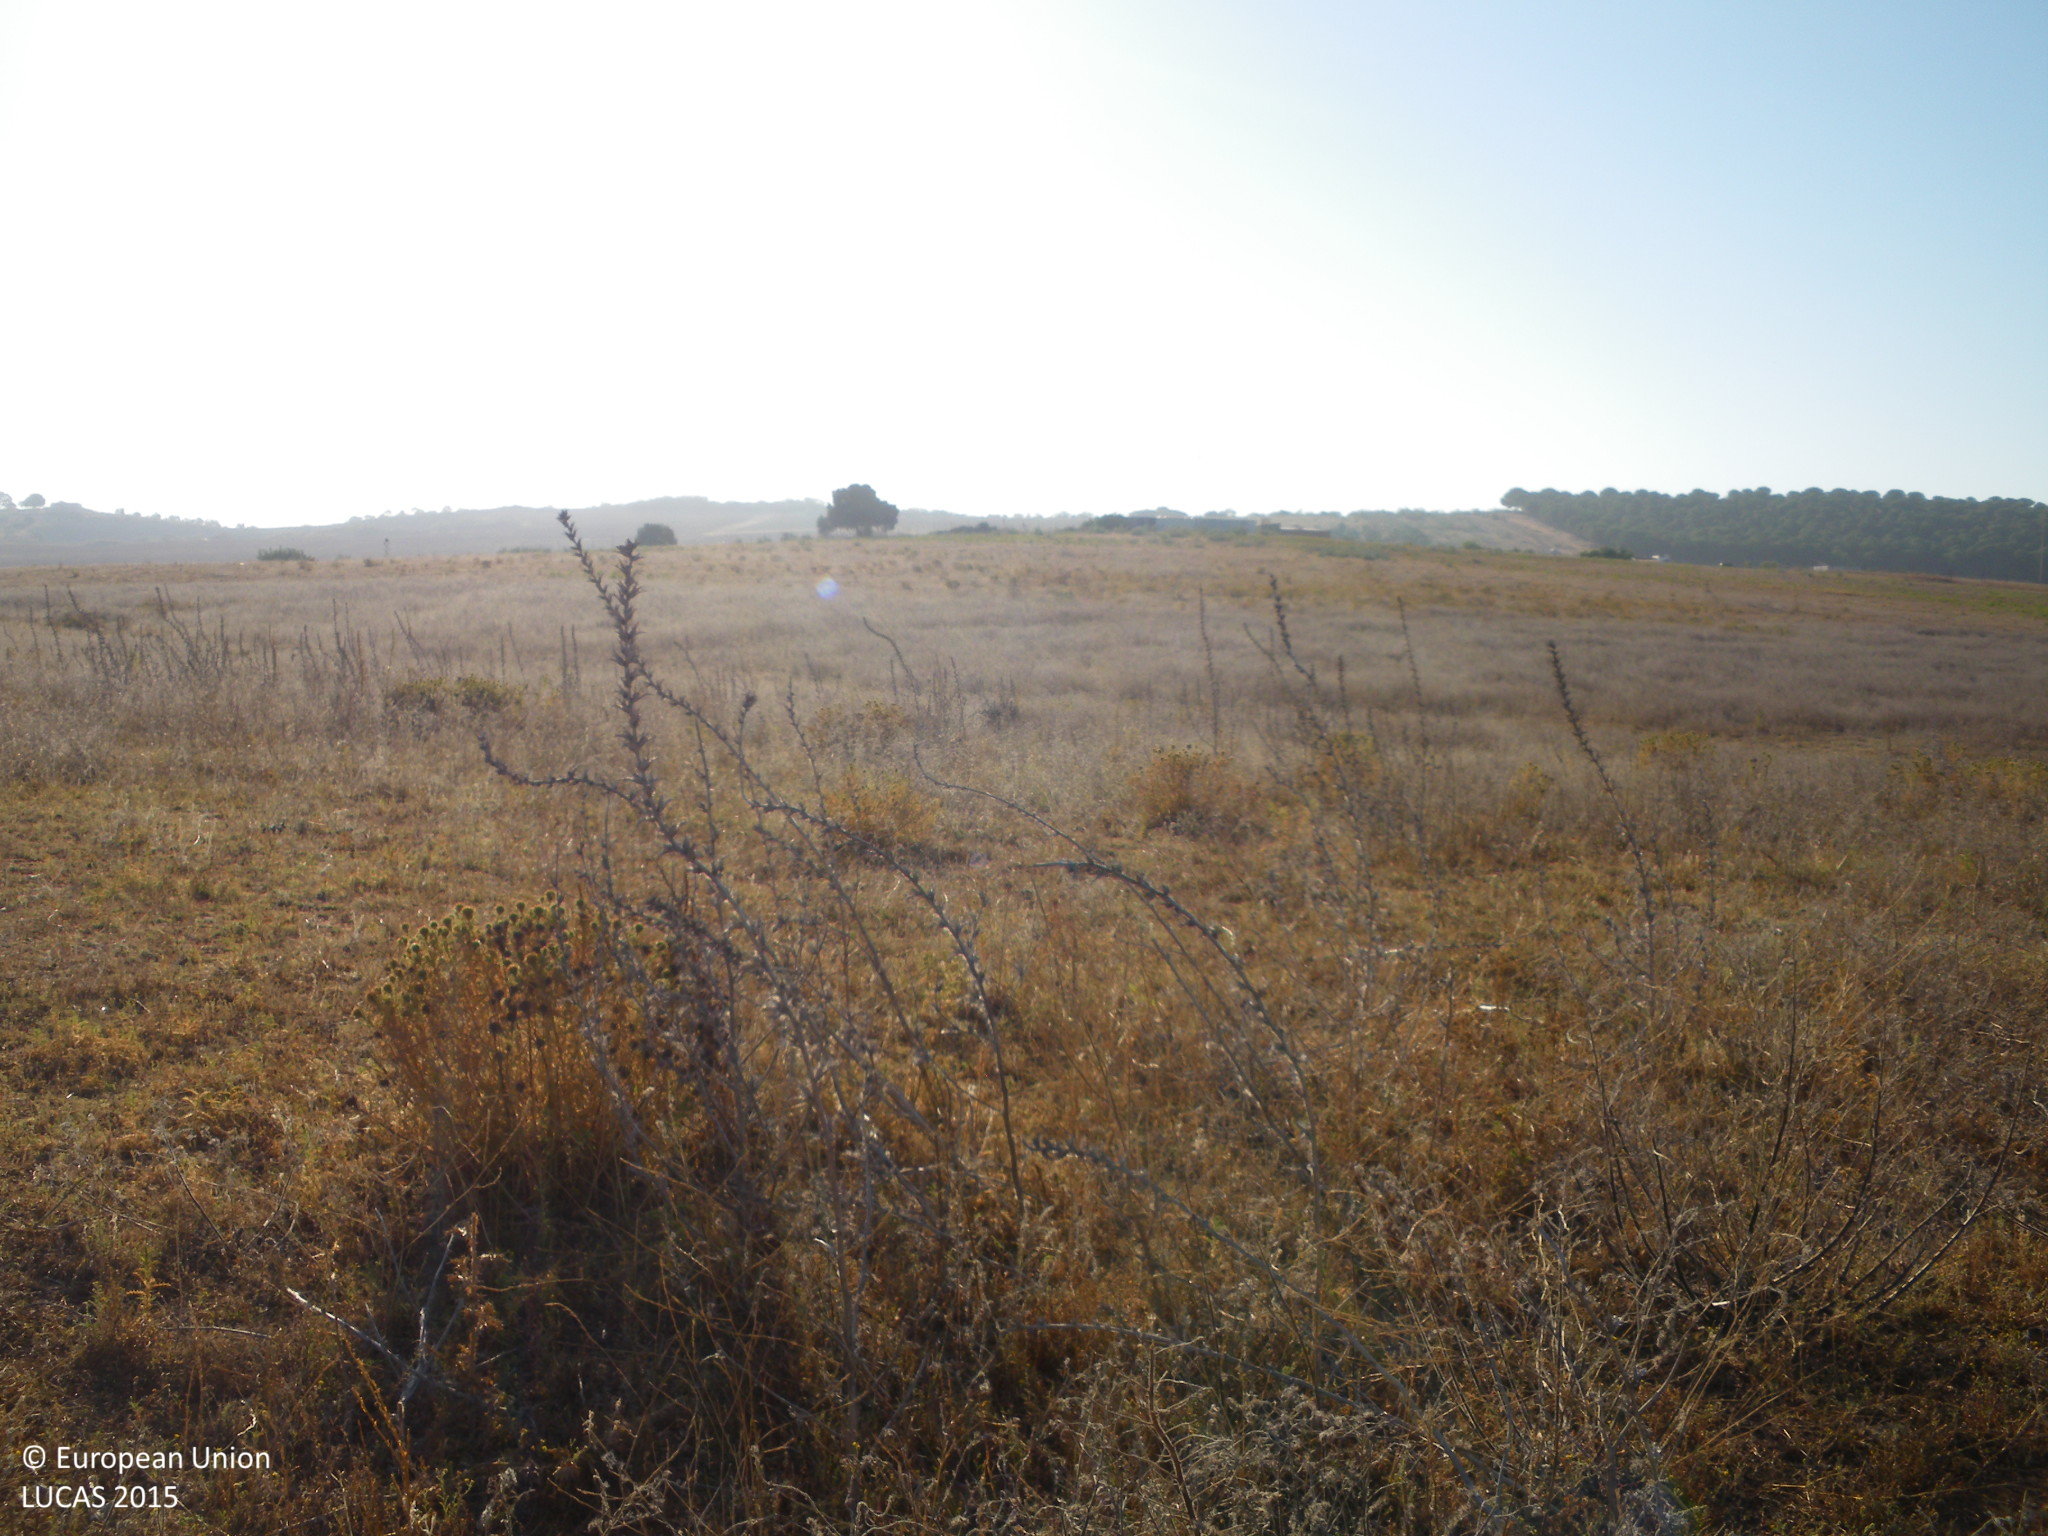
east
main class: Grassland
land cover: Grassland without tree/shrub cover
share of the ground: > 75 %
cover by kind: herbaceous plants 95 %, unconsolidated bare surface 5 %
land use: Agriculture (excluding fallow land and kitchen gardens)
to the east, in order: Grassland without tree/shrub cover; Other structural elements; Grassland without tree/shrub cover
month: June
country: ES
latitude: 36.8296
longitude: -5.7622
